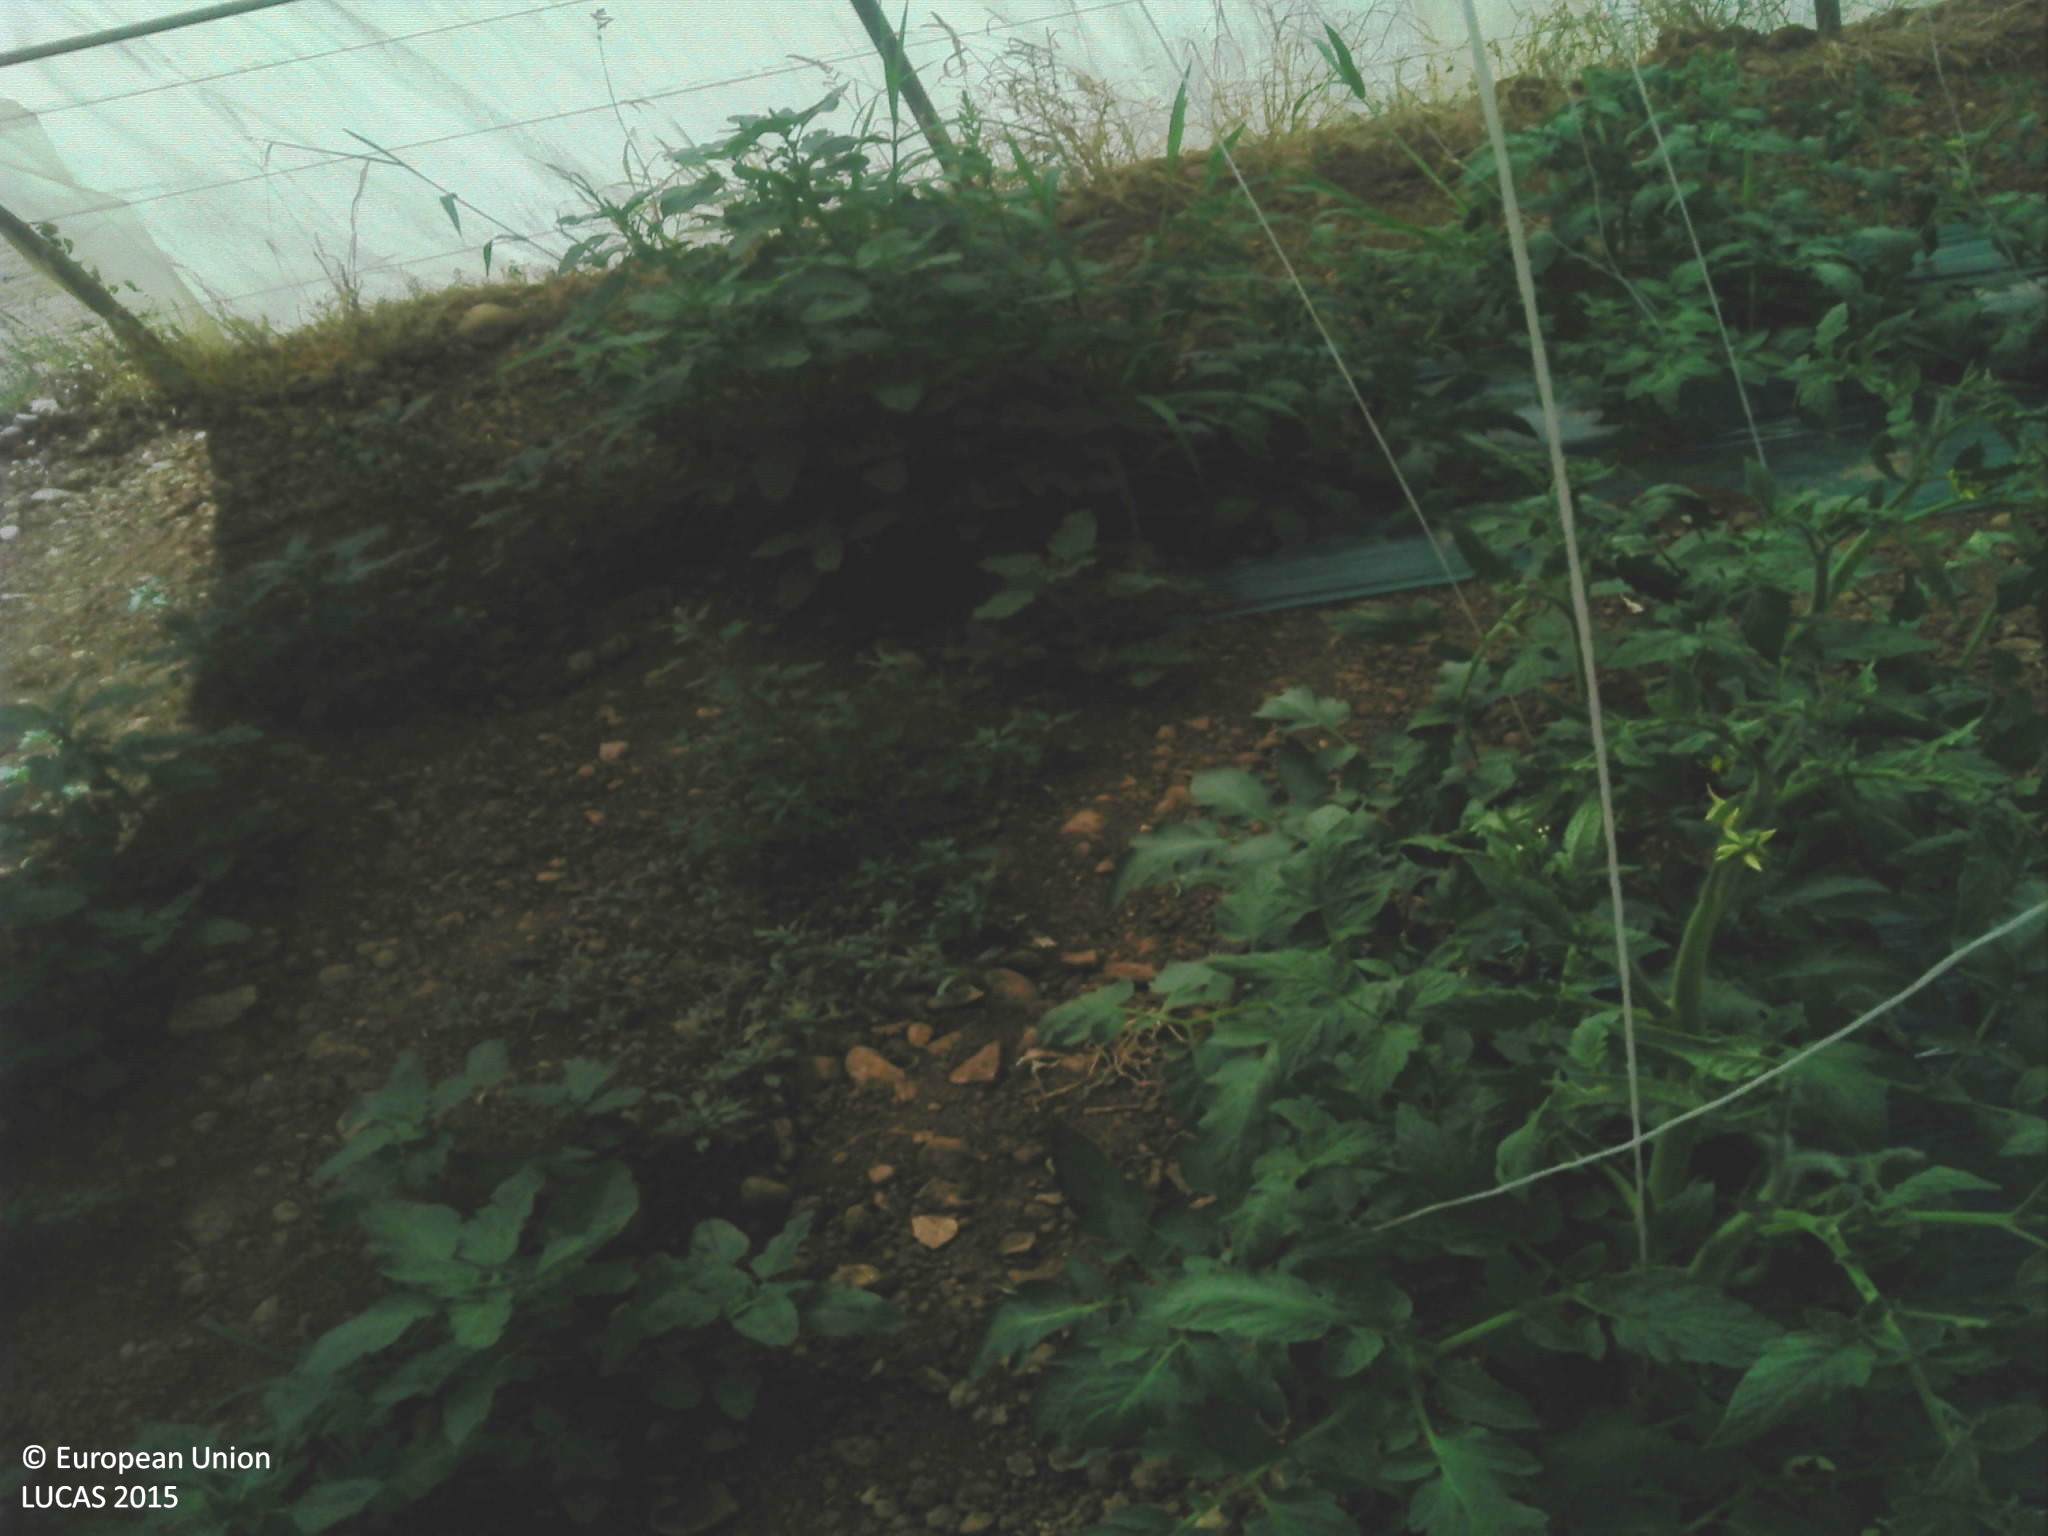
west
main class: Artificial land
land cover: Greenhouses
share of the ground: > 75 %
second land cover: Tomatoes
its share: > 75 %
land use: Agriculture (excluding fallow land and kitchen gardens)
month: July
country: FR
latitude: 43.6618
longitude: 4.8384
